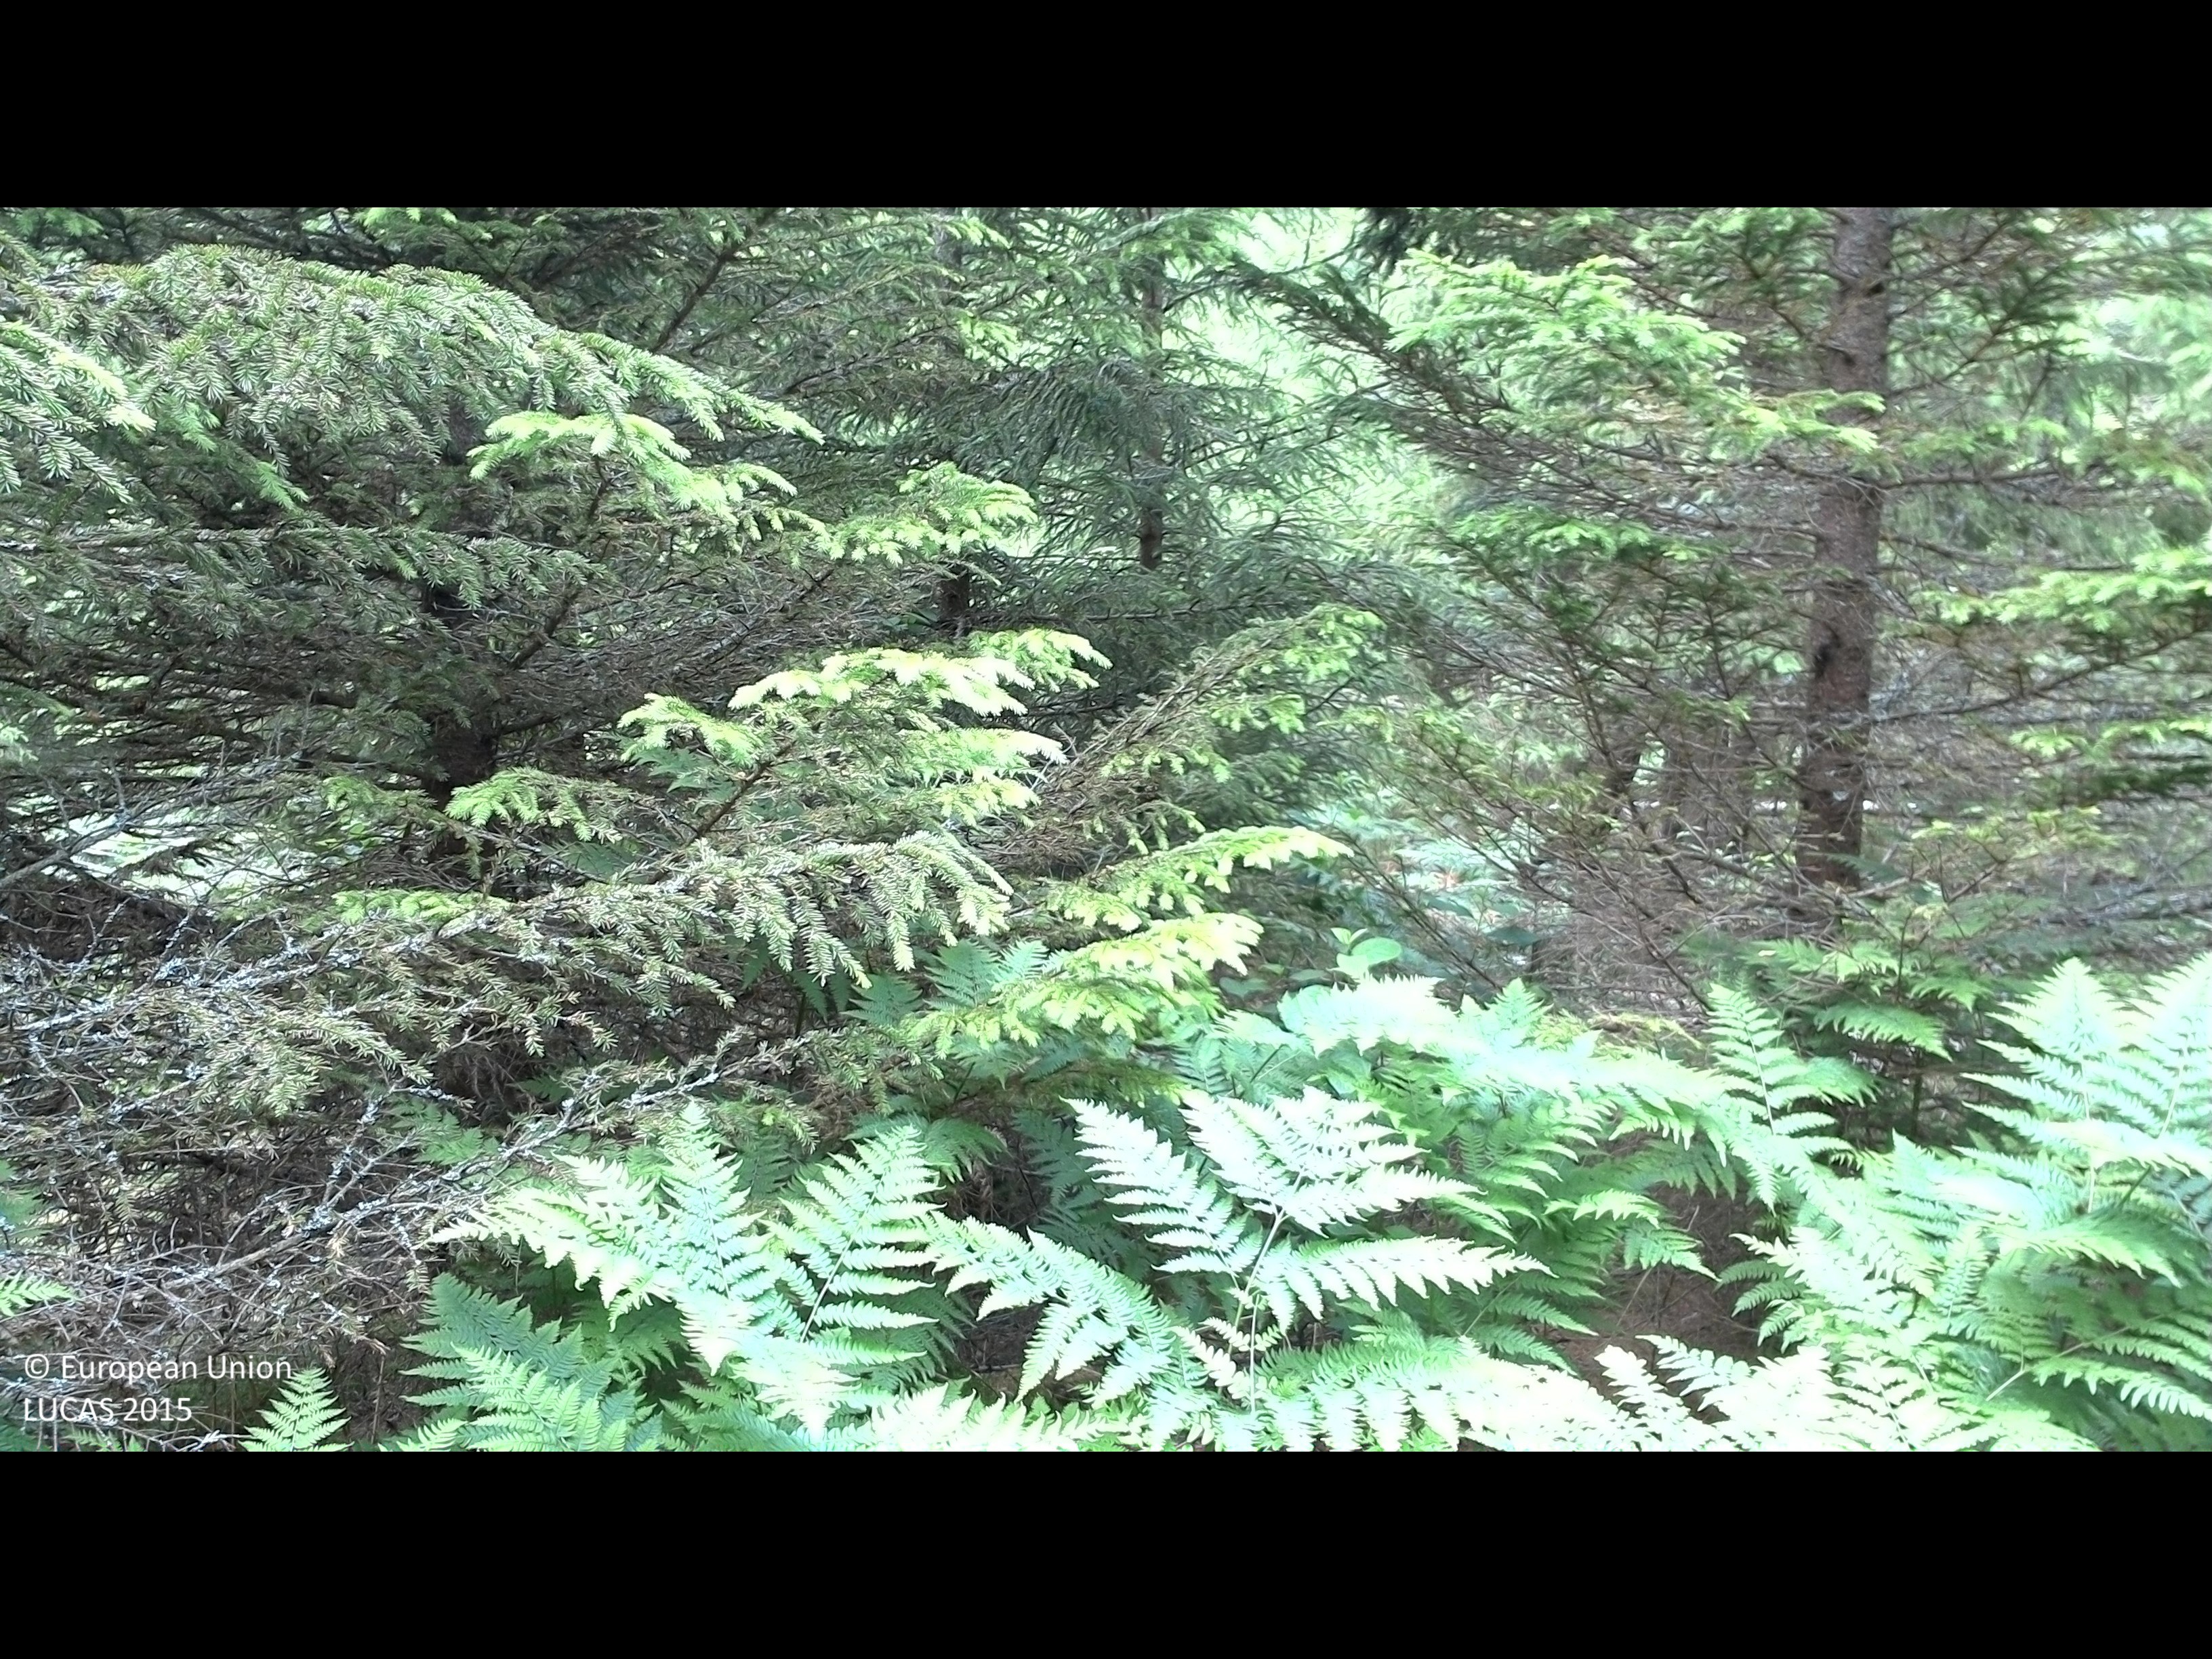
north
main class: Woodland
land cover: Spruce dominated coniferous woodland
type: boreal forest
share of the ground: > 75 %
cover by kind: coniferous forest trees 75 %, shrubs 10 %, herbaceous plants 10 %, broadleaved forest trees 5 %
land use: Forestry
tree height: < 5 m
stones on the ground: < 10 %
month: July
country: SE
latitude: 56.4959
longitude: 14.7571
